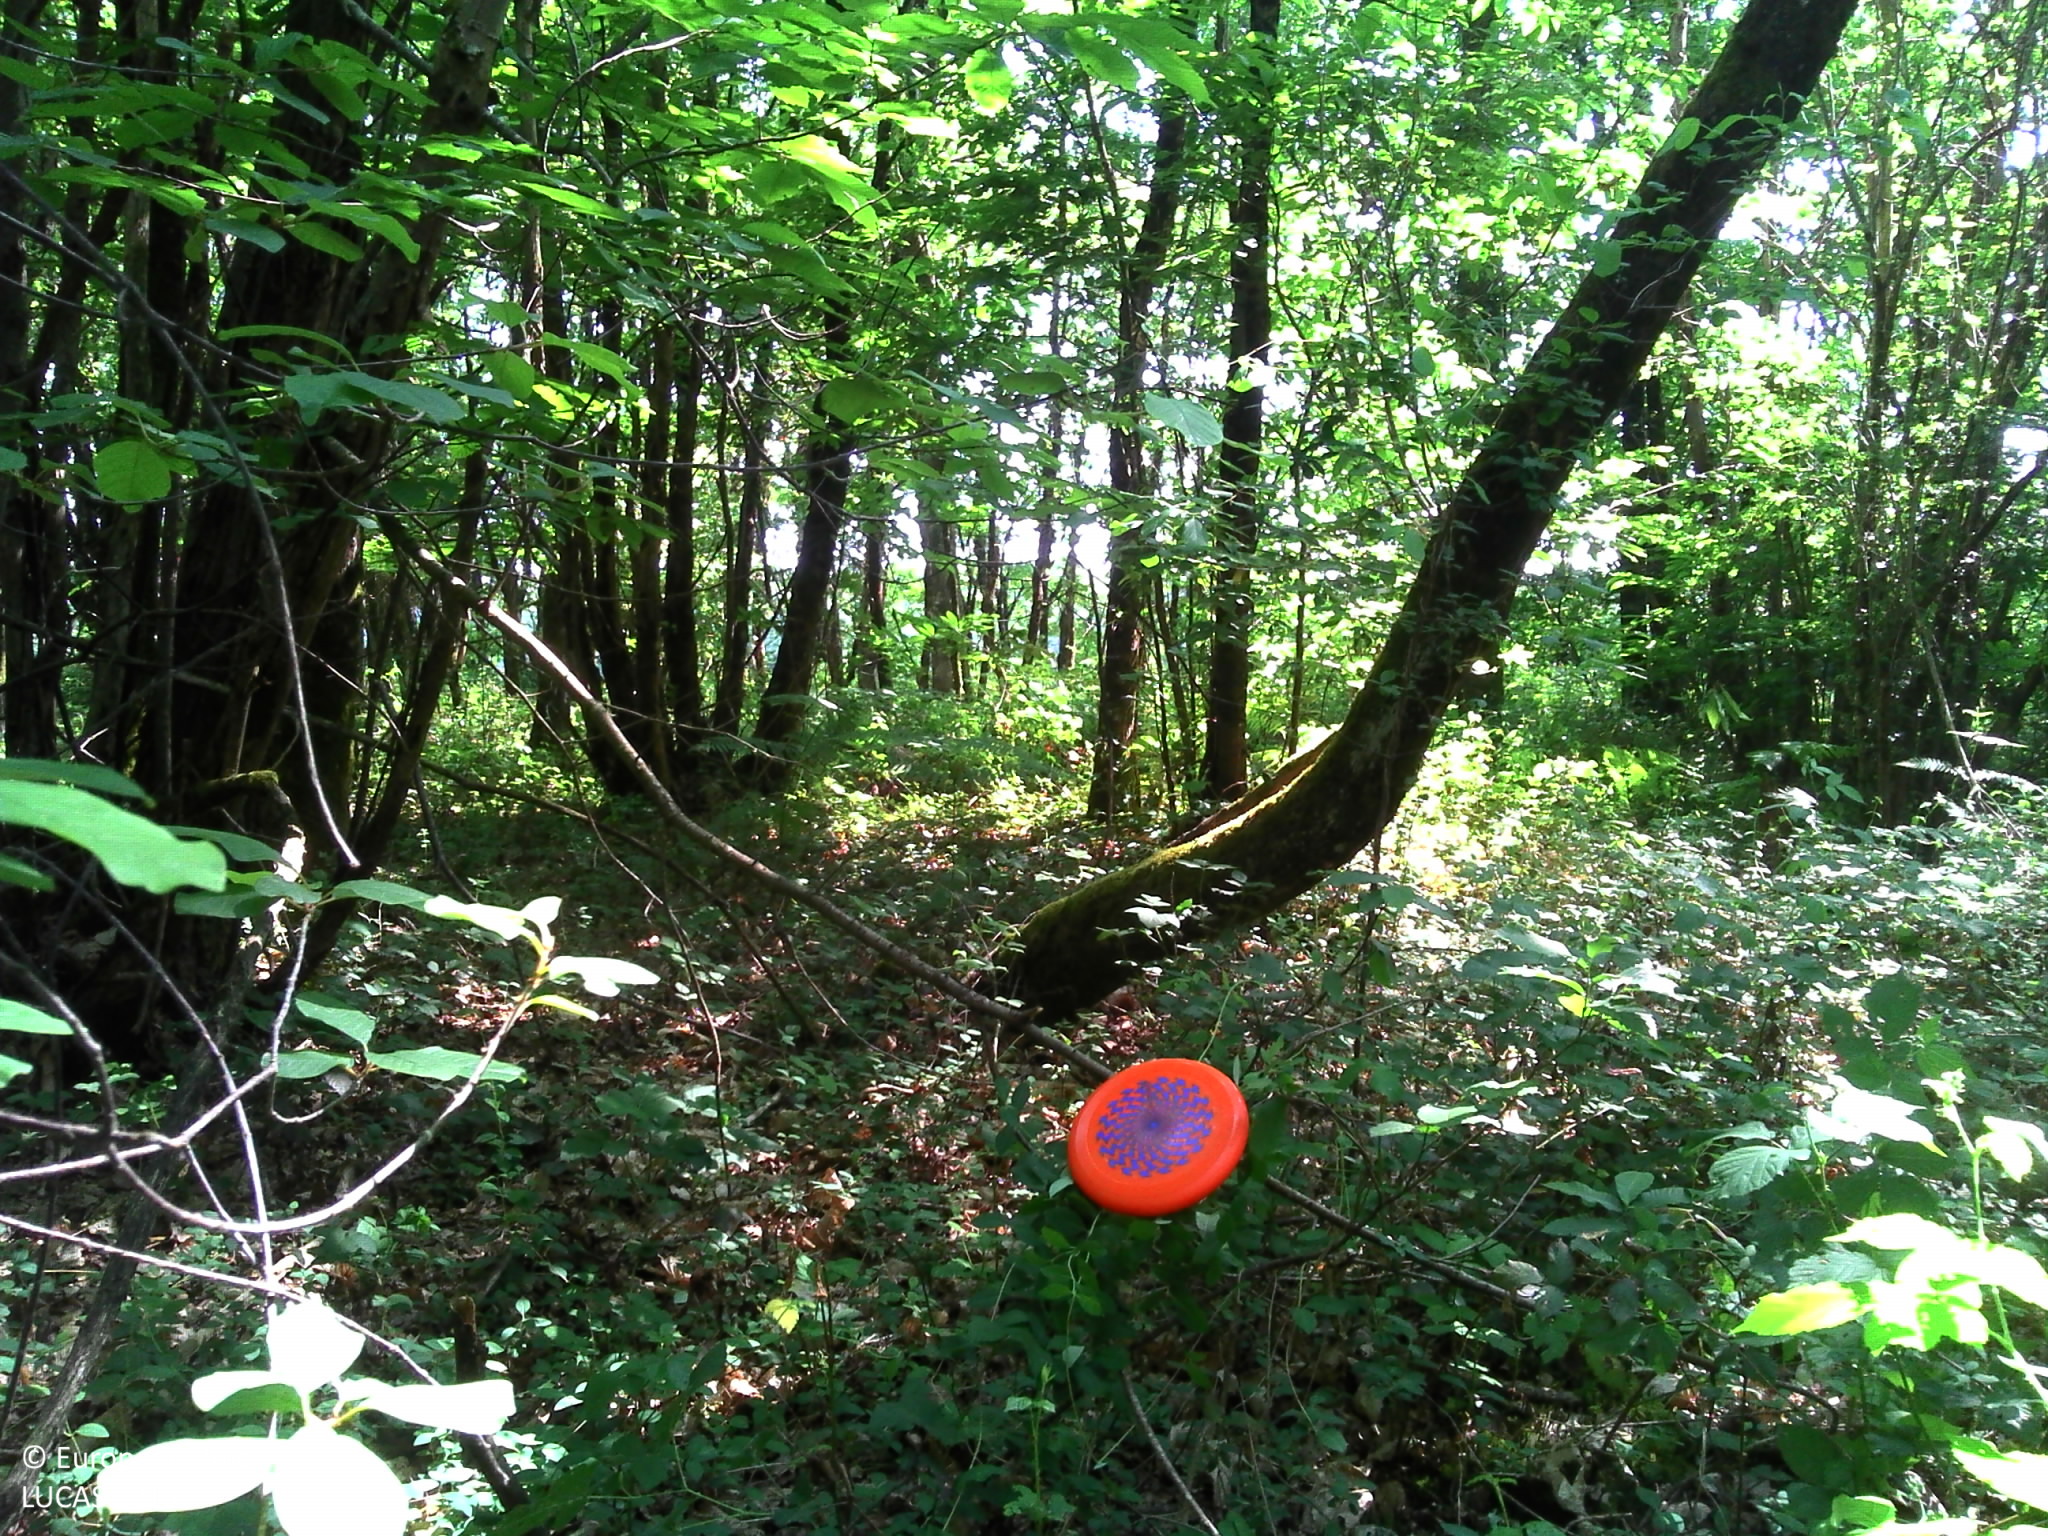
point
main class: Woodland
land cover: Broadleaved woodland
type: acidophilous oak and oak-birch forest
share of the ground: > 75 %
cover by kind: broadleaved forest trees 100 %
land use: Forestry
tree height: > 5 m
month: June
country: FR
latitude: 46.0823
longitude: 0.6098
